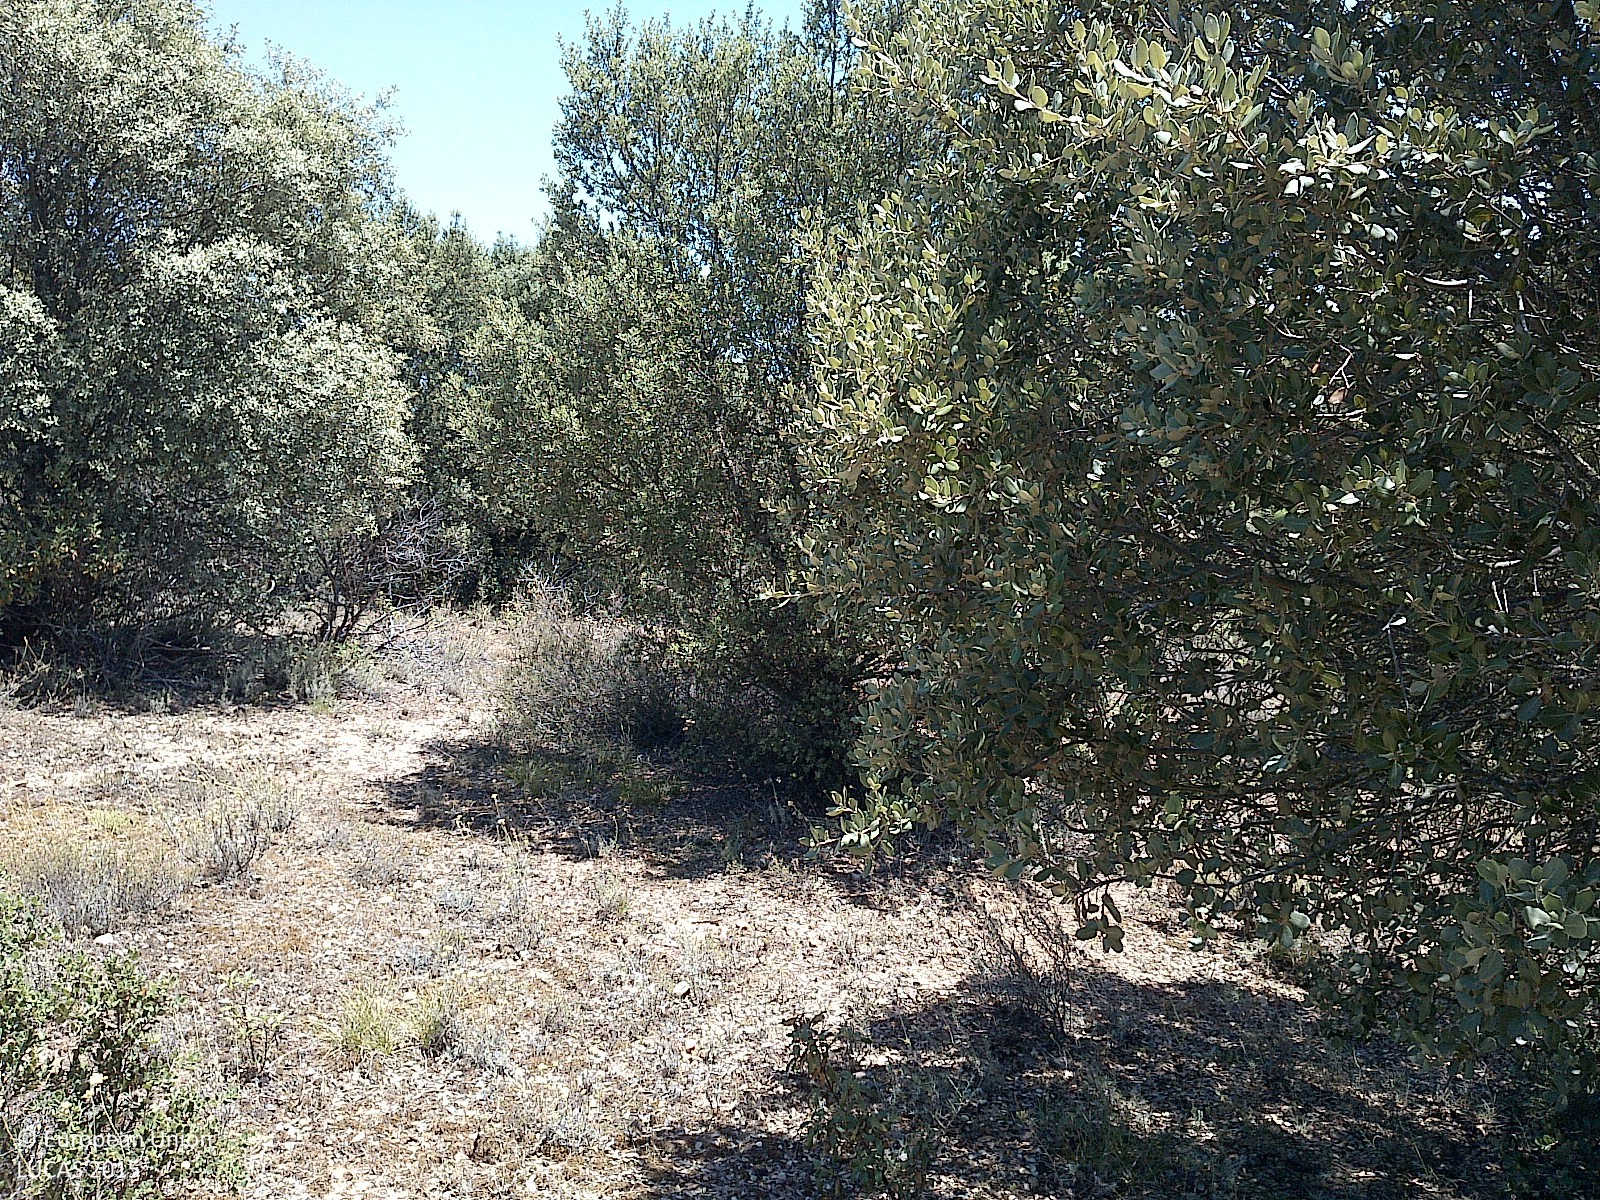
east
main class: Woodland
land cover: Broadleaved woodland
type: broadleaved evergreen forest
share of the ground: 25 - 50 %
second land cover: Grassland without tree/shrub cover
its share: > 75 %
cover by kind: shrubs 40 %, broadleaved forest trees 35 %, herbaceous plants 25 %
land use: Forestry
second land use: Agriculture (excluding fallow land and kitchen gardens)
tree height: < 5 m
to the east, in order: Broadleaved woodland; Grassland without tree/shrub cover; Grassland with sparse tree/shrub cover; Tracks; Grass margins; Rye; Broadleaved woodland; Shrubland with sparse tree cover
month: July
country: ES
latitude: 41.6649
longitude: -3.1481
